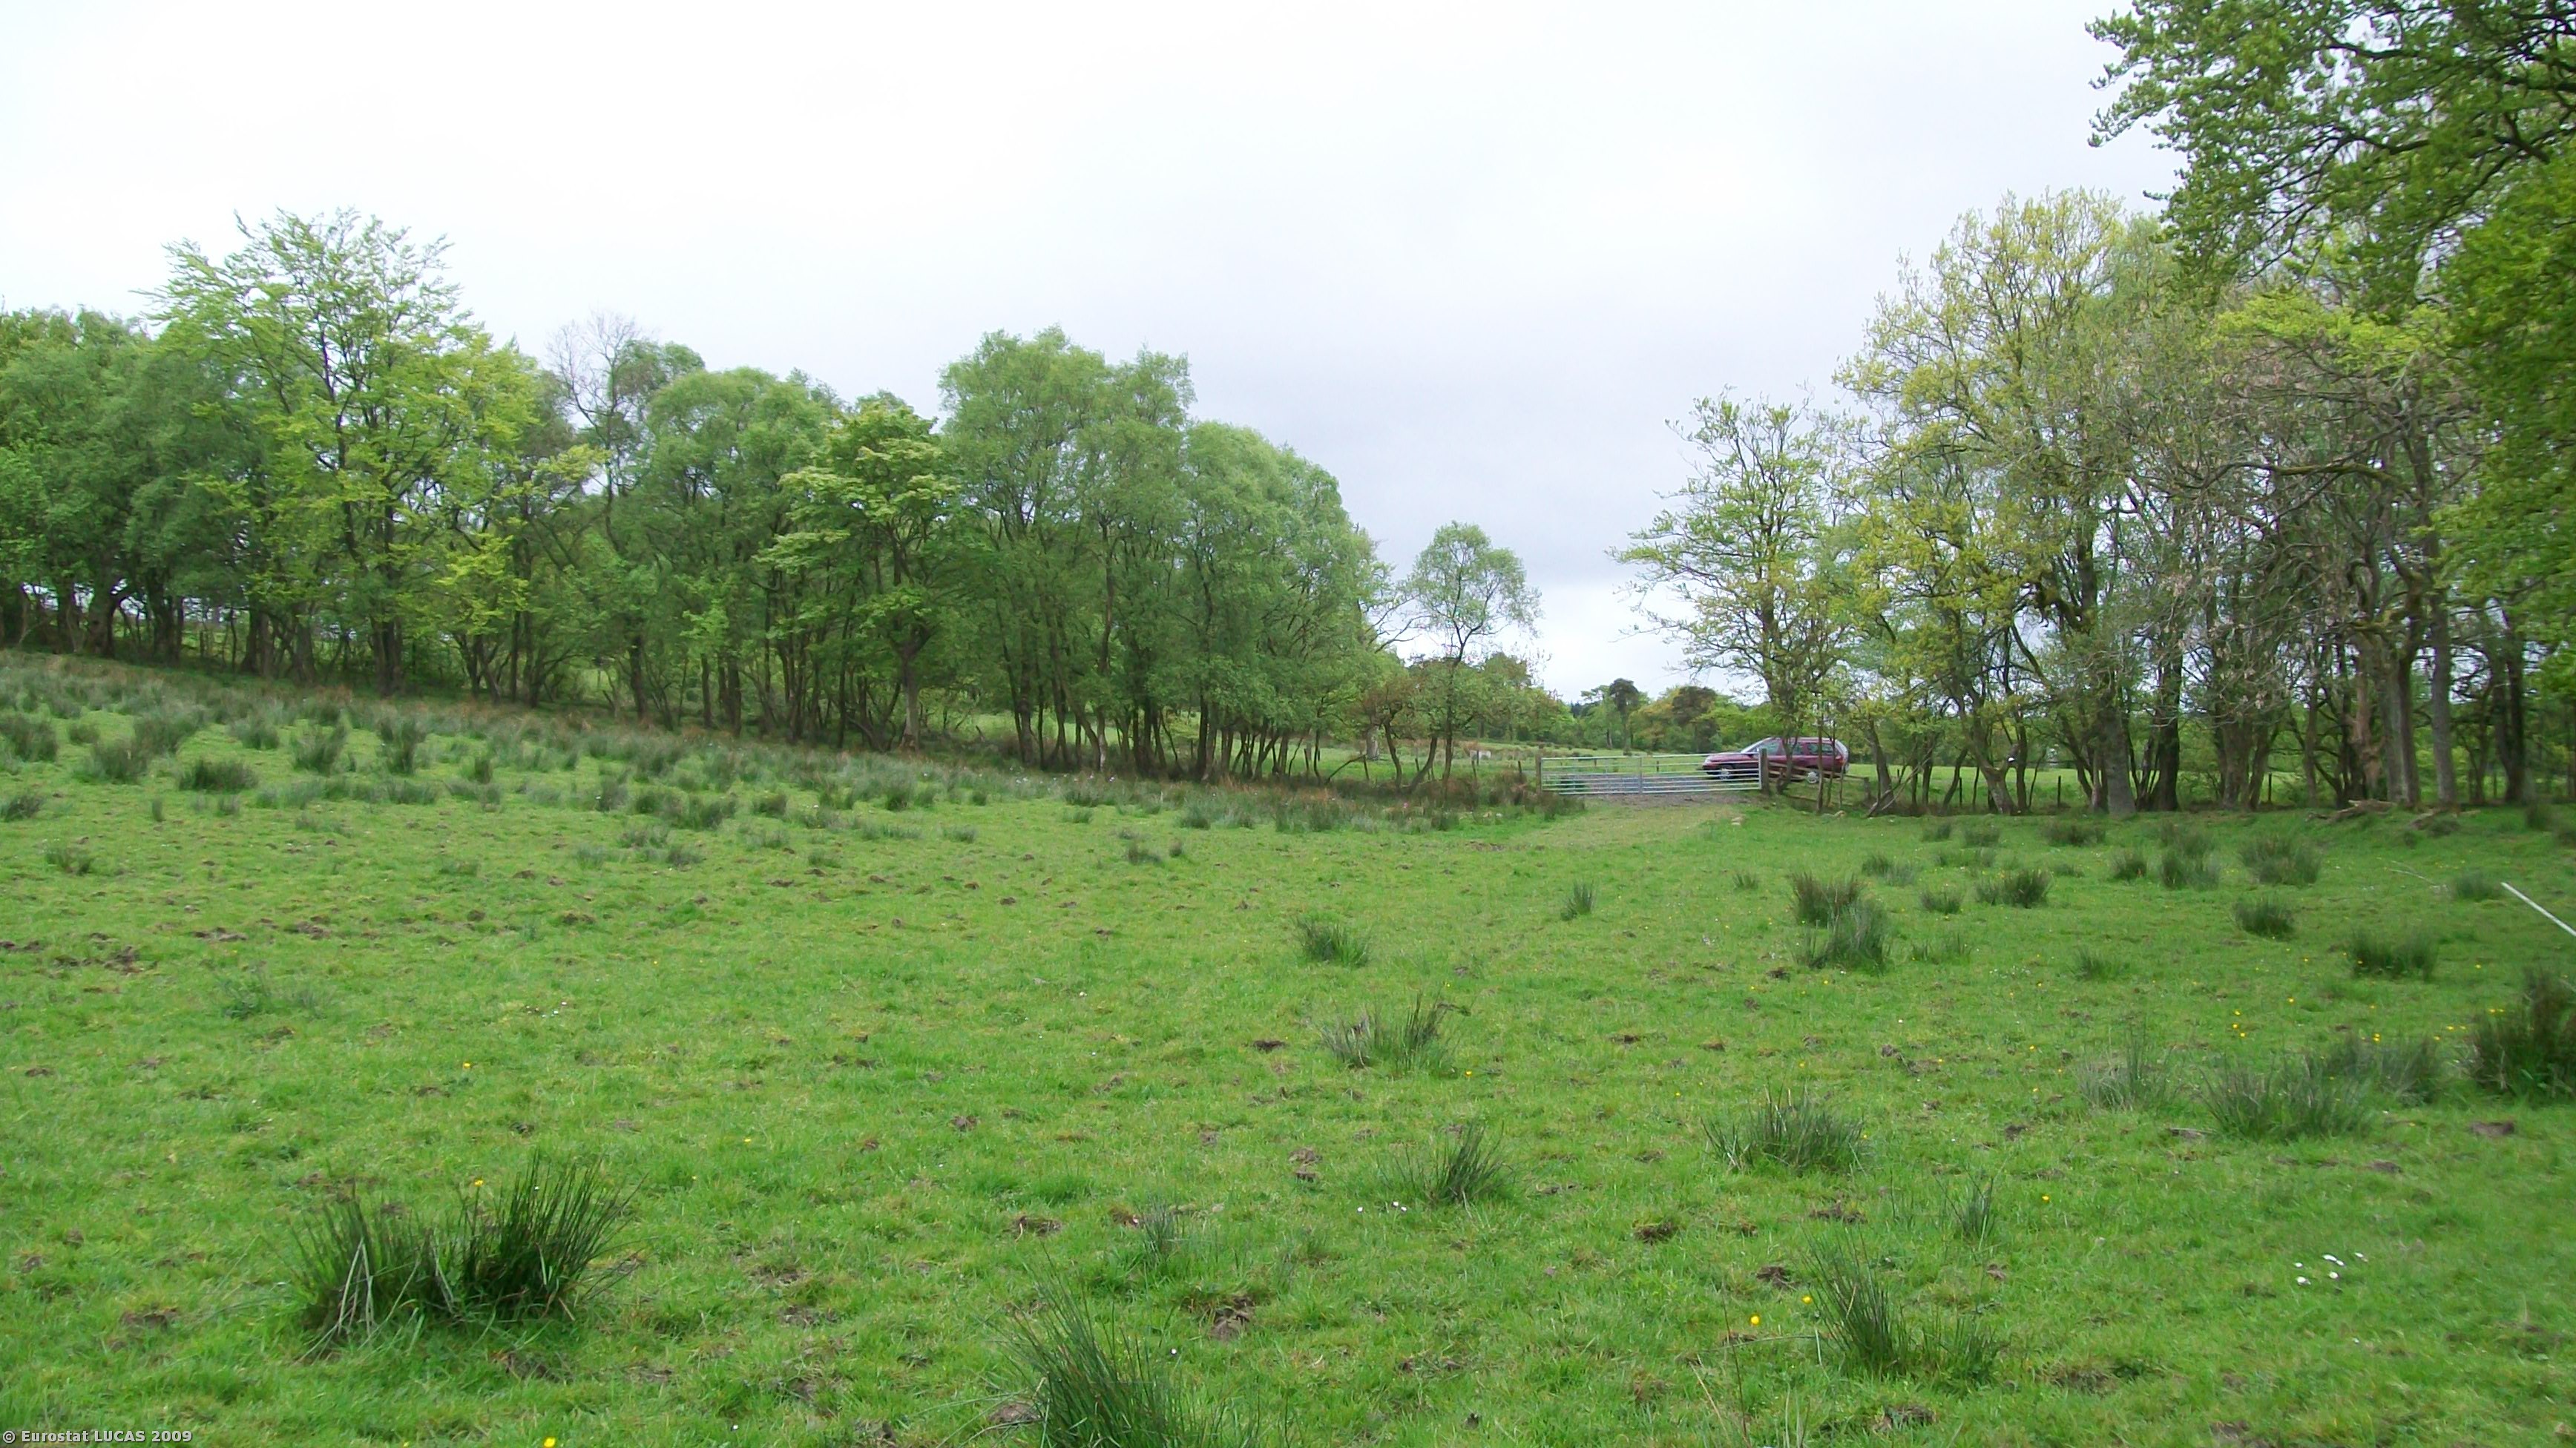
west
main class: Grassland
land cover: Grassland without tree/shrub cover
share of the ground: > 75 %
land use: Agriculture (excluding fallow land and kitchen gardens)
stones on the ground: < 10 %
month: May
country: GB
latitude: 55.8278
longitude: -3.5685
